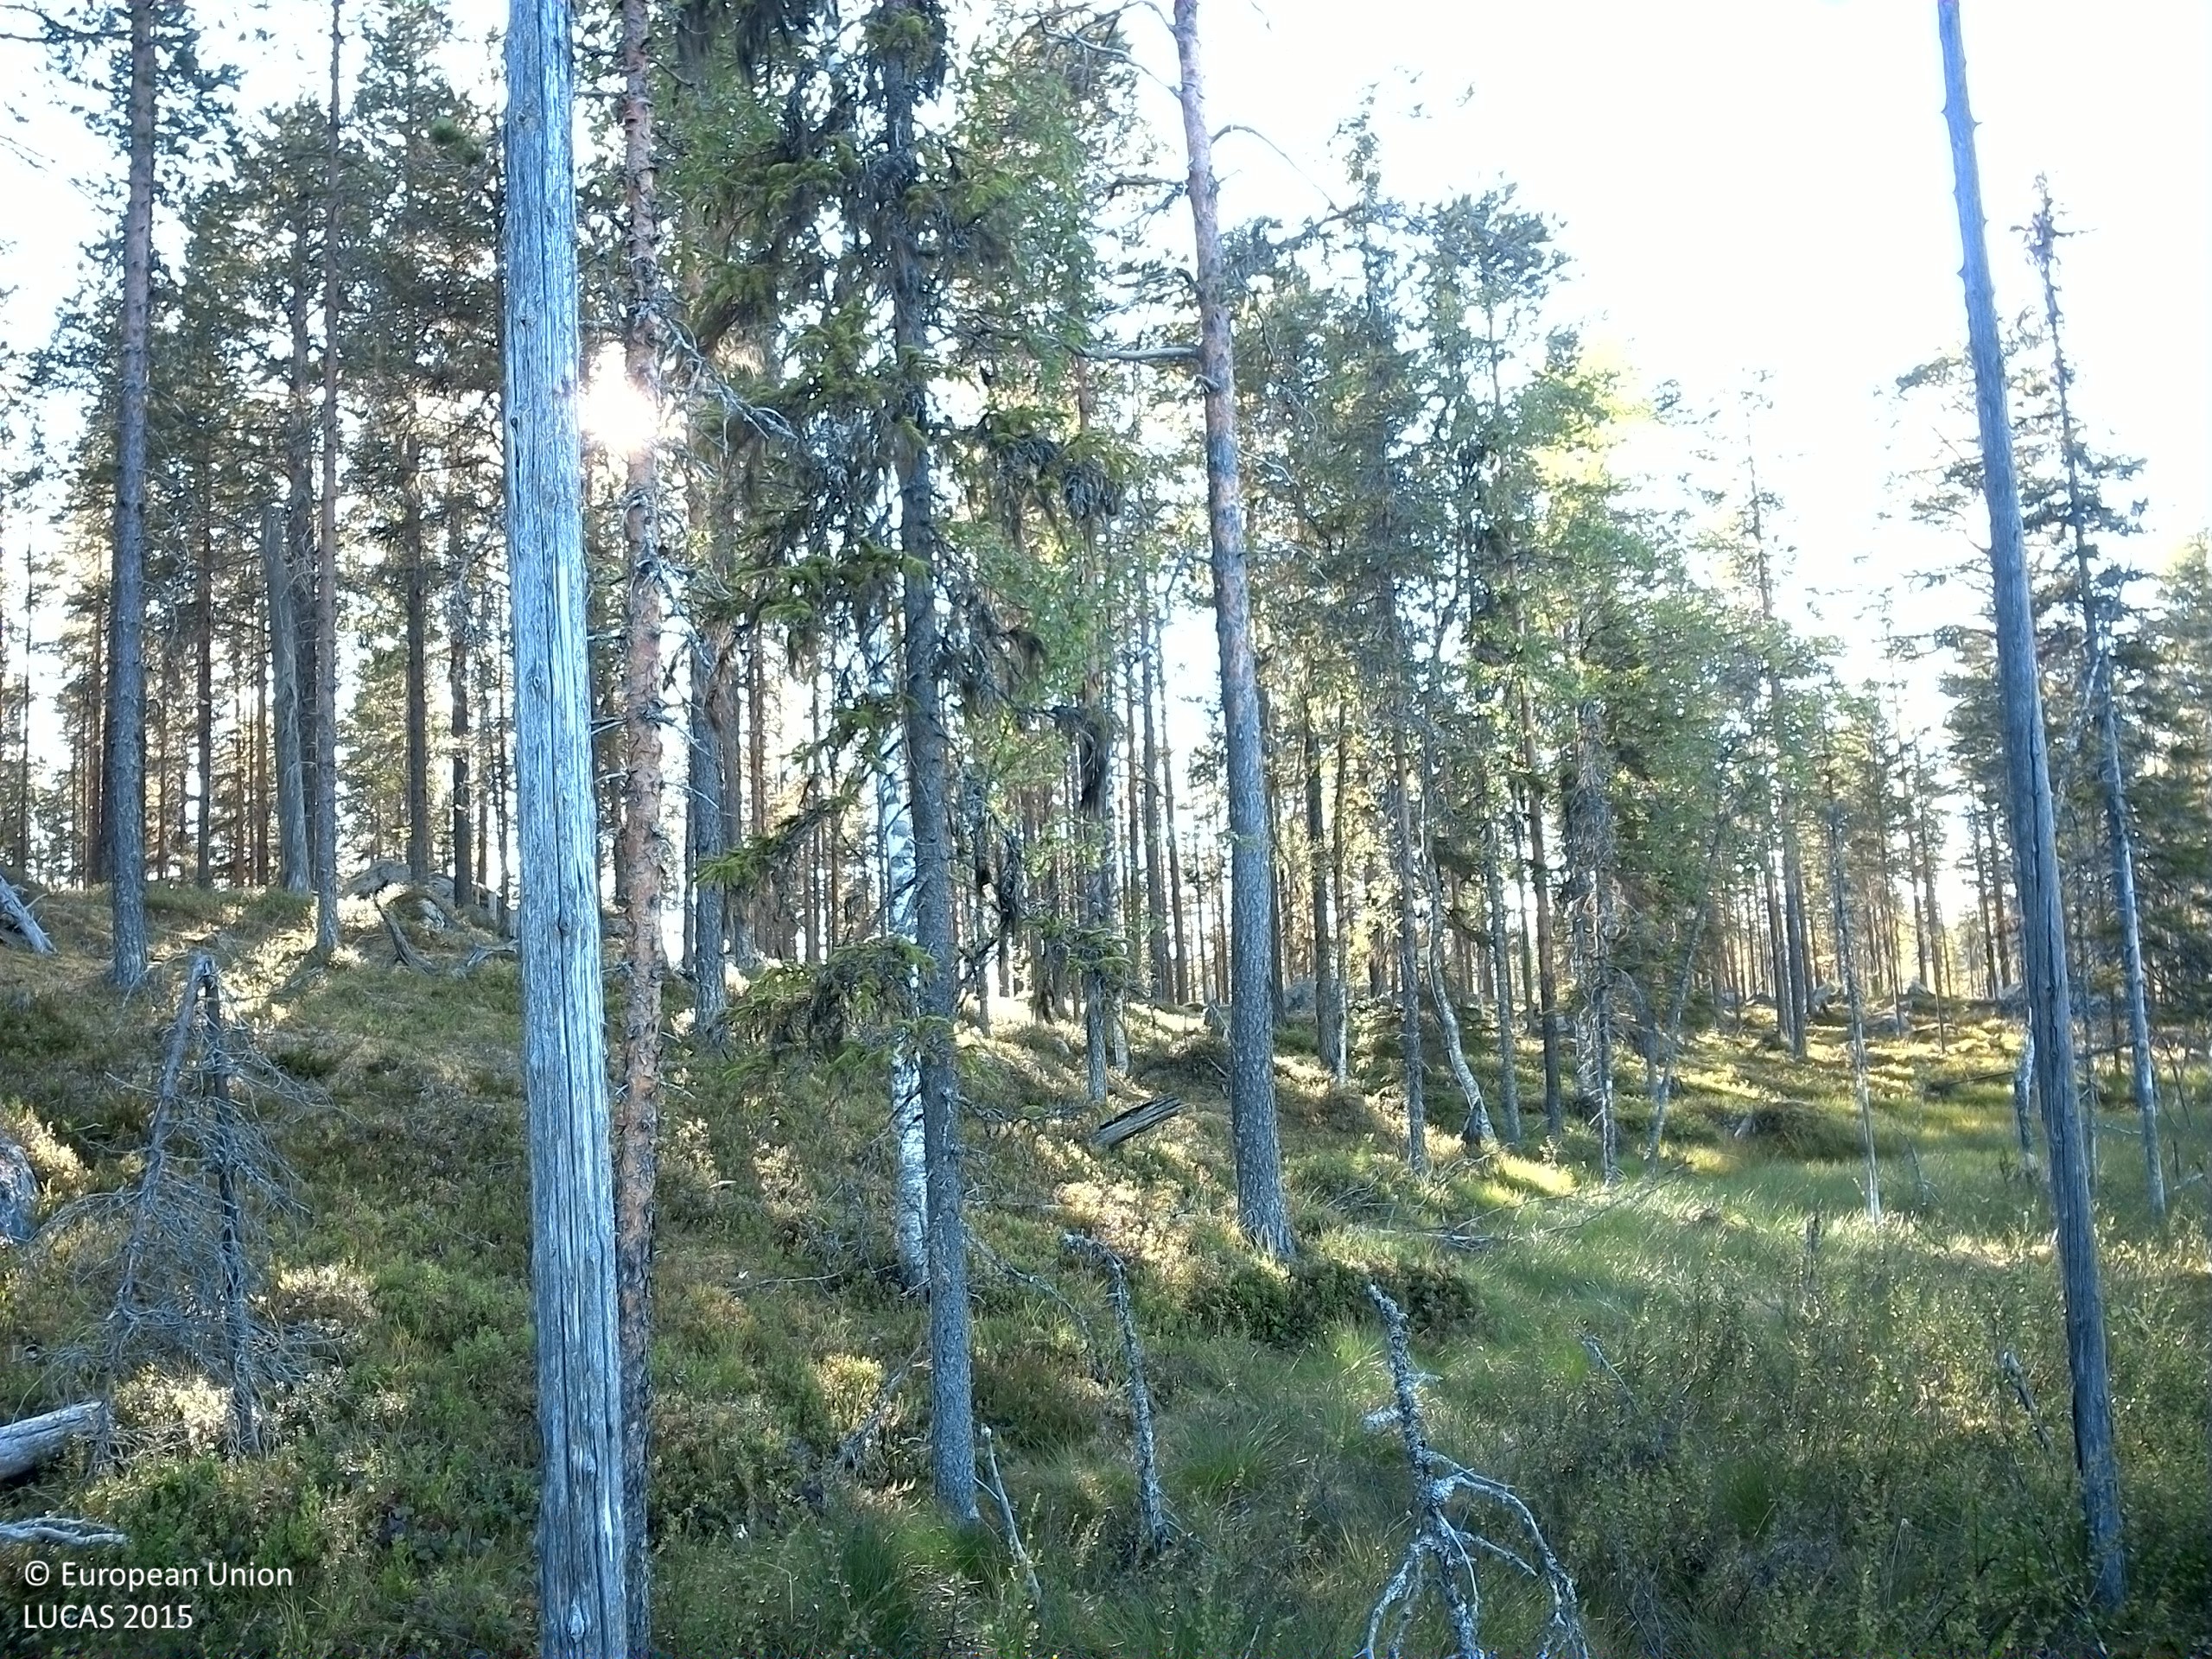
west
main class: Woodland
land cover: Broadleaved woodland
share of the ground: 25 - 50 %
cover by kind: broadleaved forest trees 40 %, herbaceous plants 30 %, lichens and mosses 25 %, shrubs 5 %
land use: Semi-natural and natural areas not in use
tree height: < 5 m
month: August
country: SE
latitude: 64.0918
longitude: 17.5394
